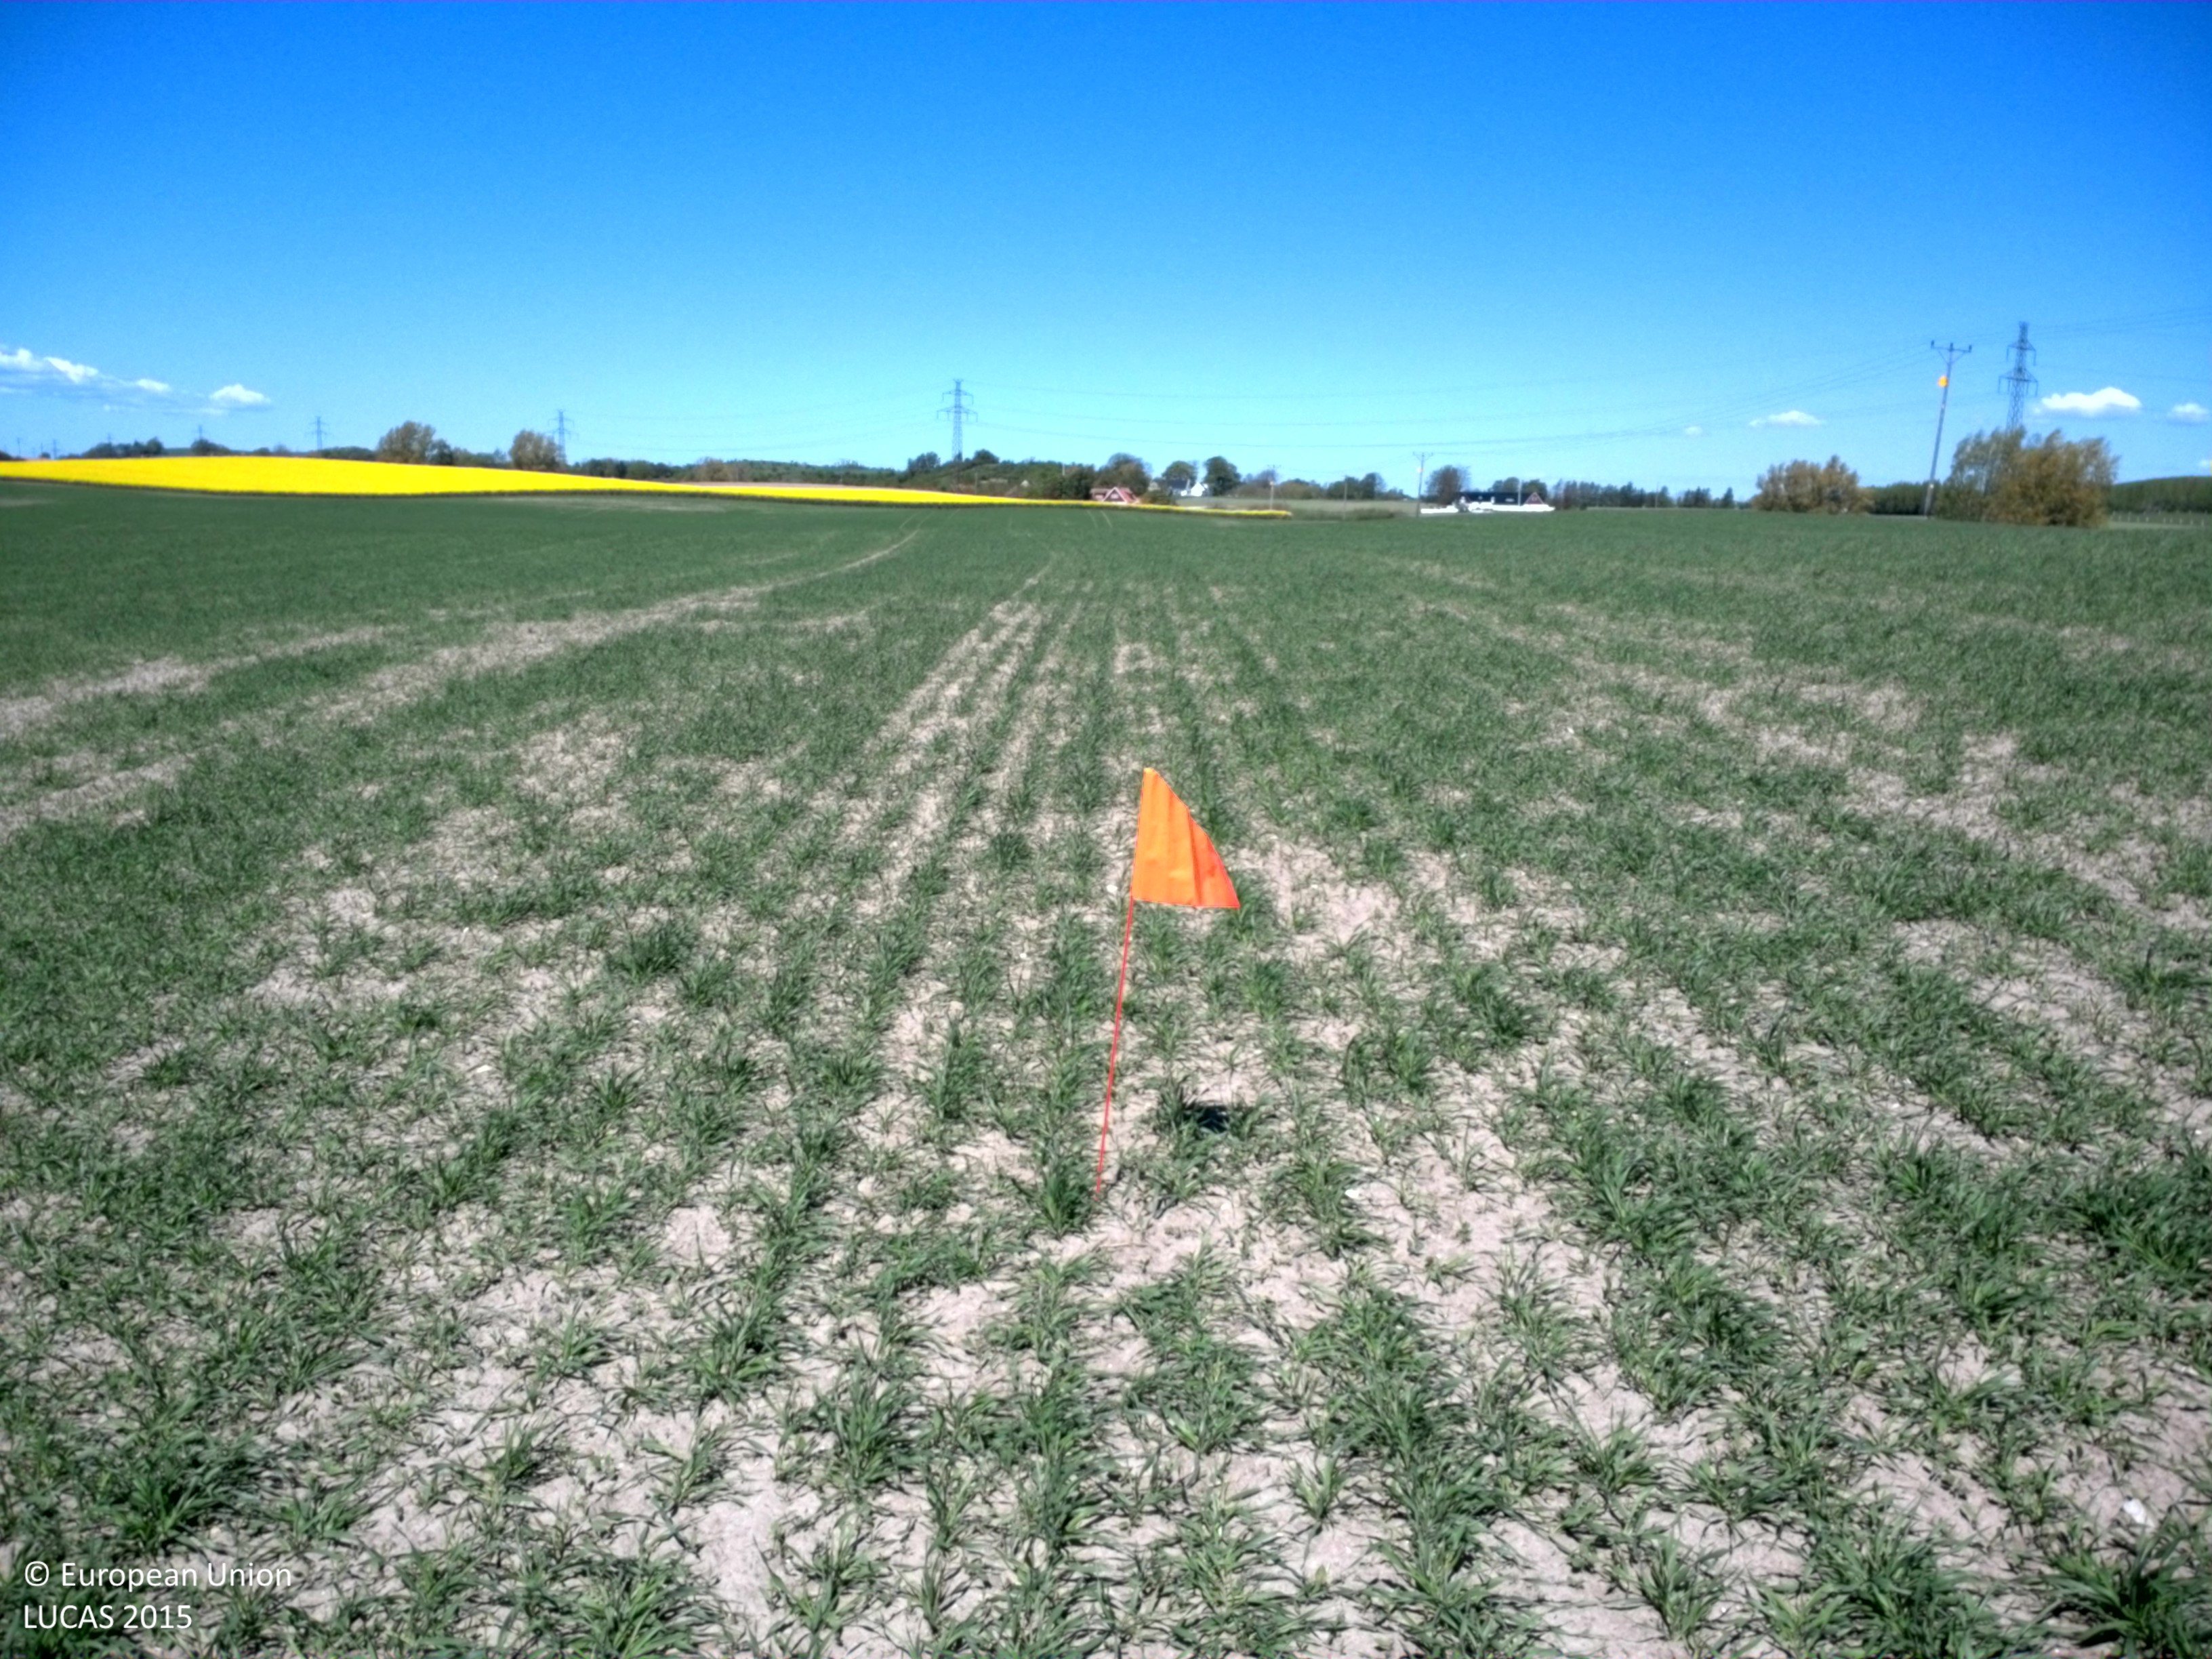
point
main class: Cropland
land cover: Barley
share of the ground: 50 - 75 %
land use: Agriculture (excluding fallow land and kitchen gardens)
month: May
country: SE
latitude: 55.5023
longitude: 13.1169
